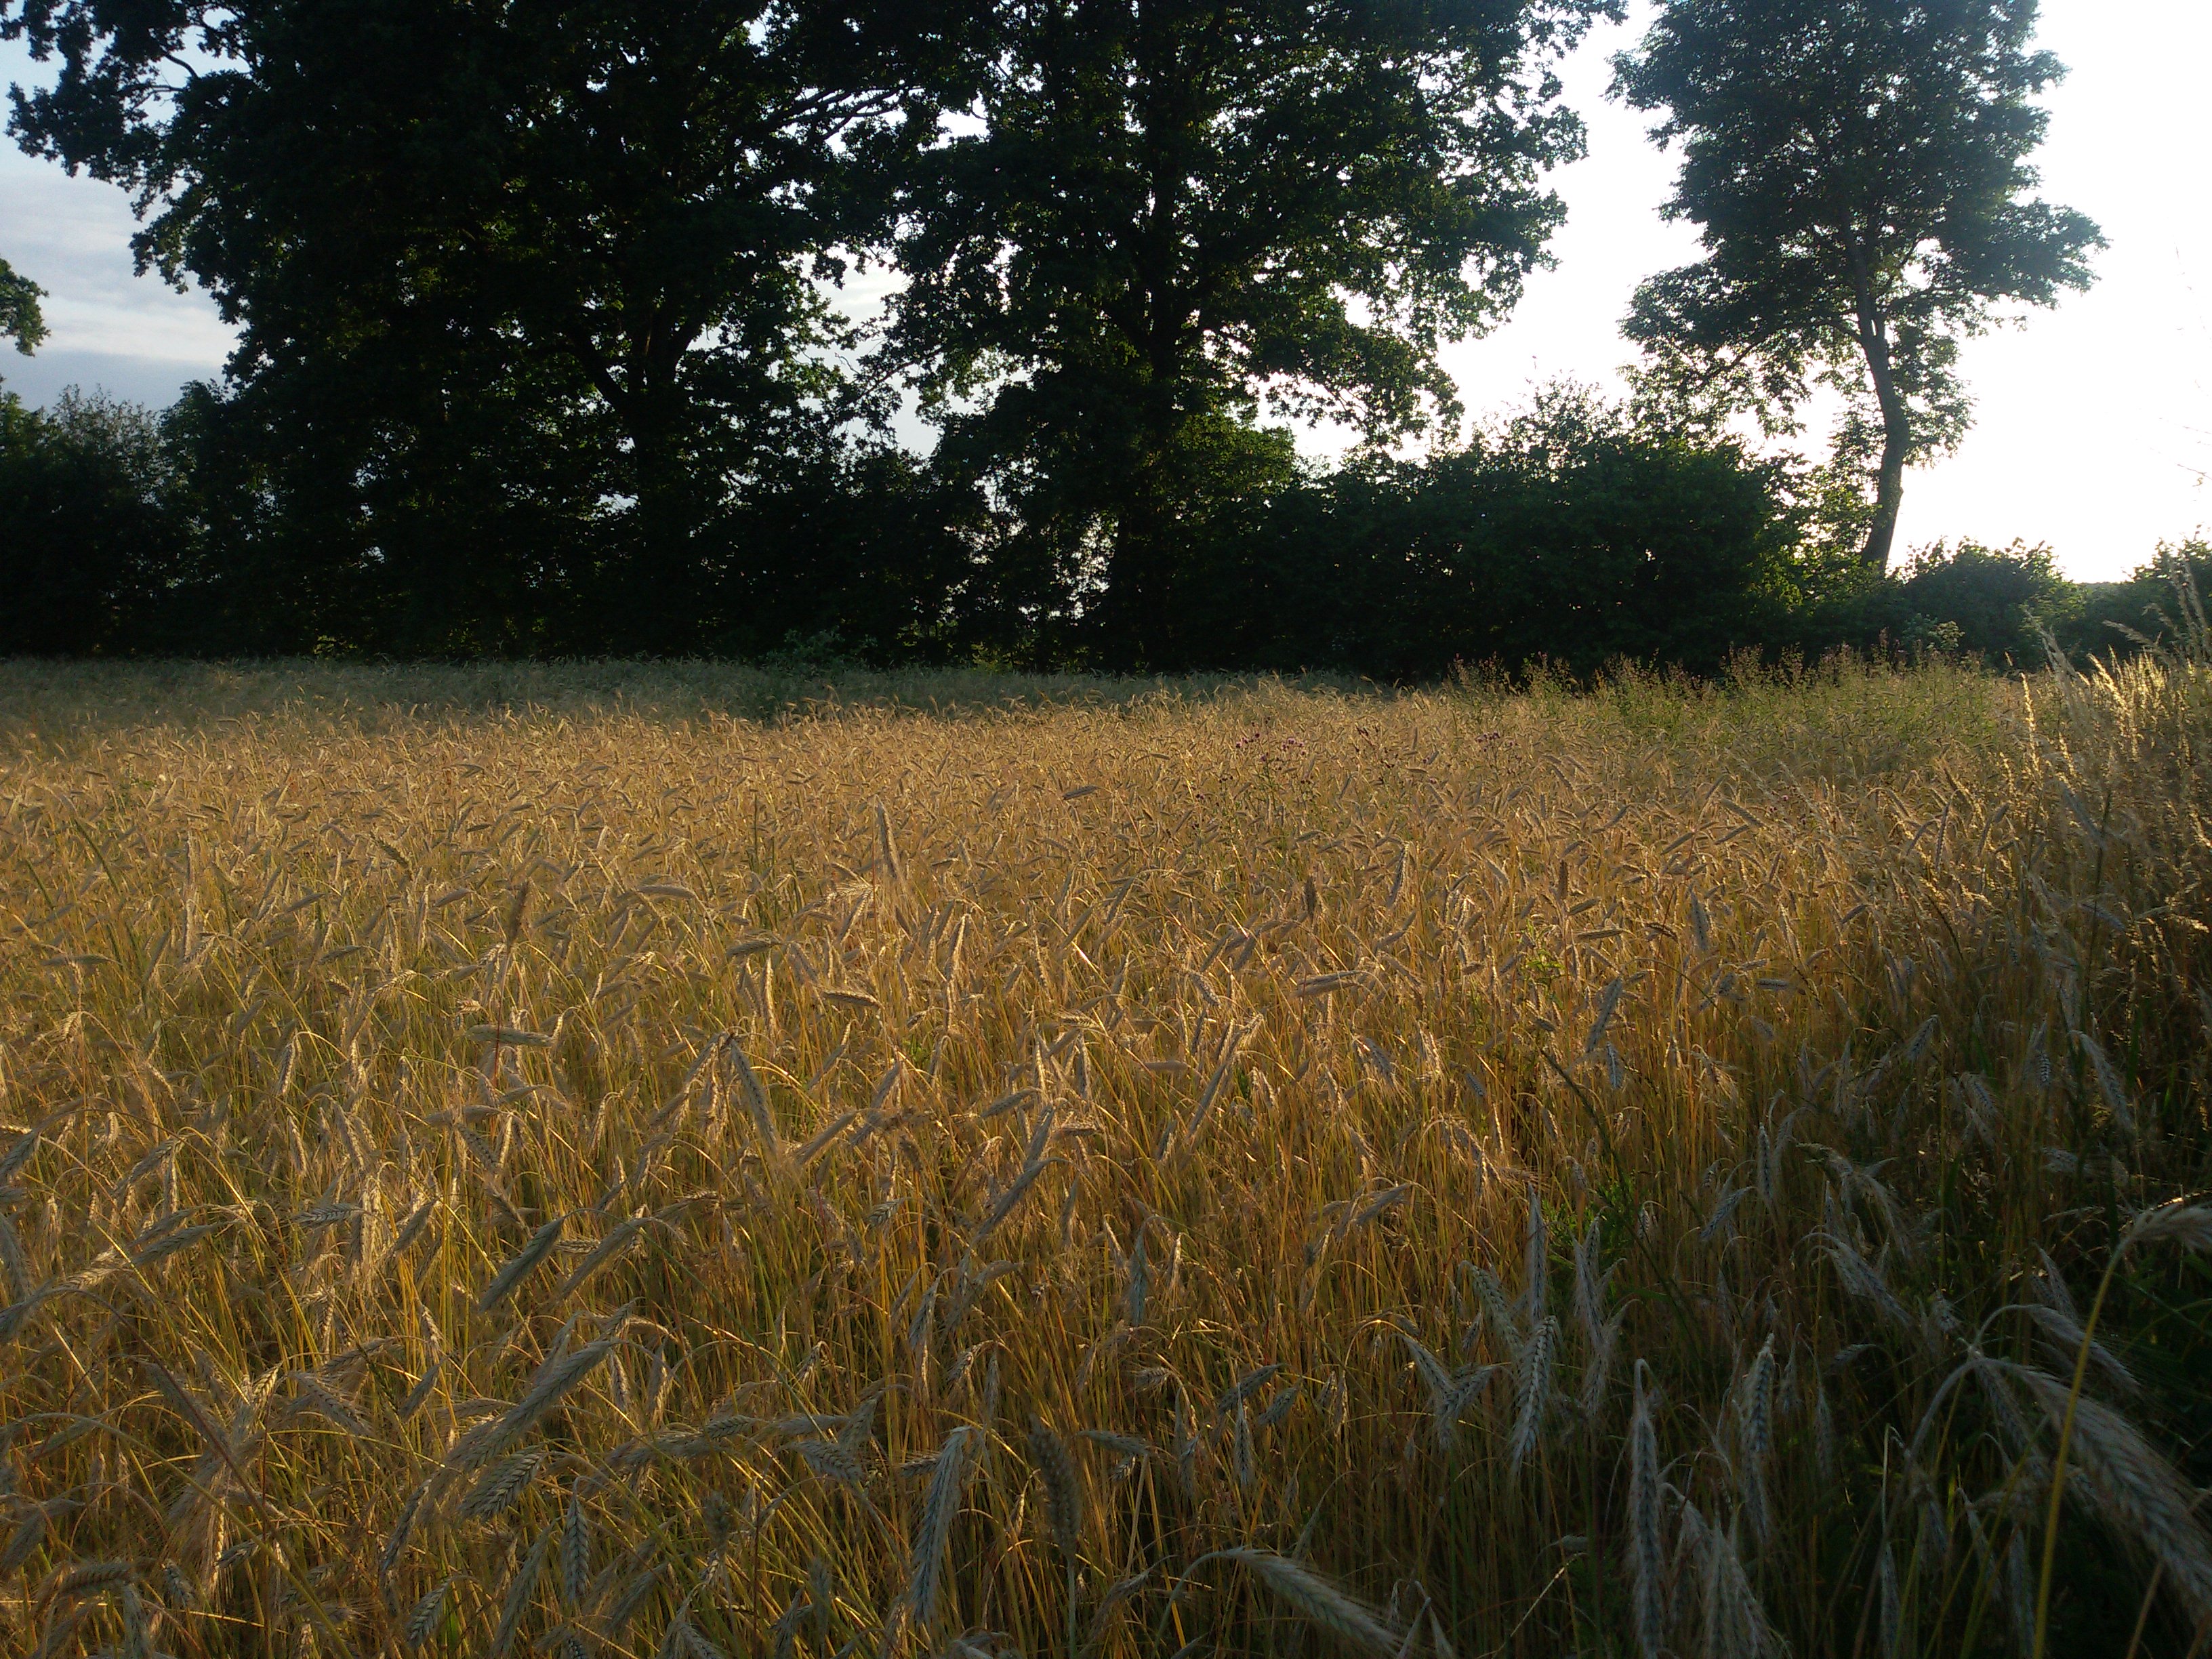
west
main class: Cropland
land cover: Rye
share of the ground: > 75 %
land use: Agriculture (excluding fallow land and kitchen gardens)
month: July
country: PL
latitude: 53.9818
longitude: 15.8443
